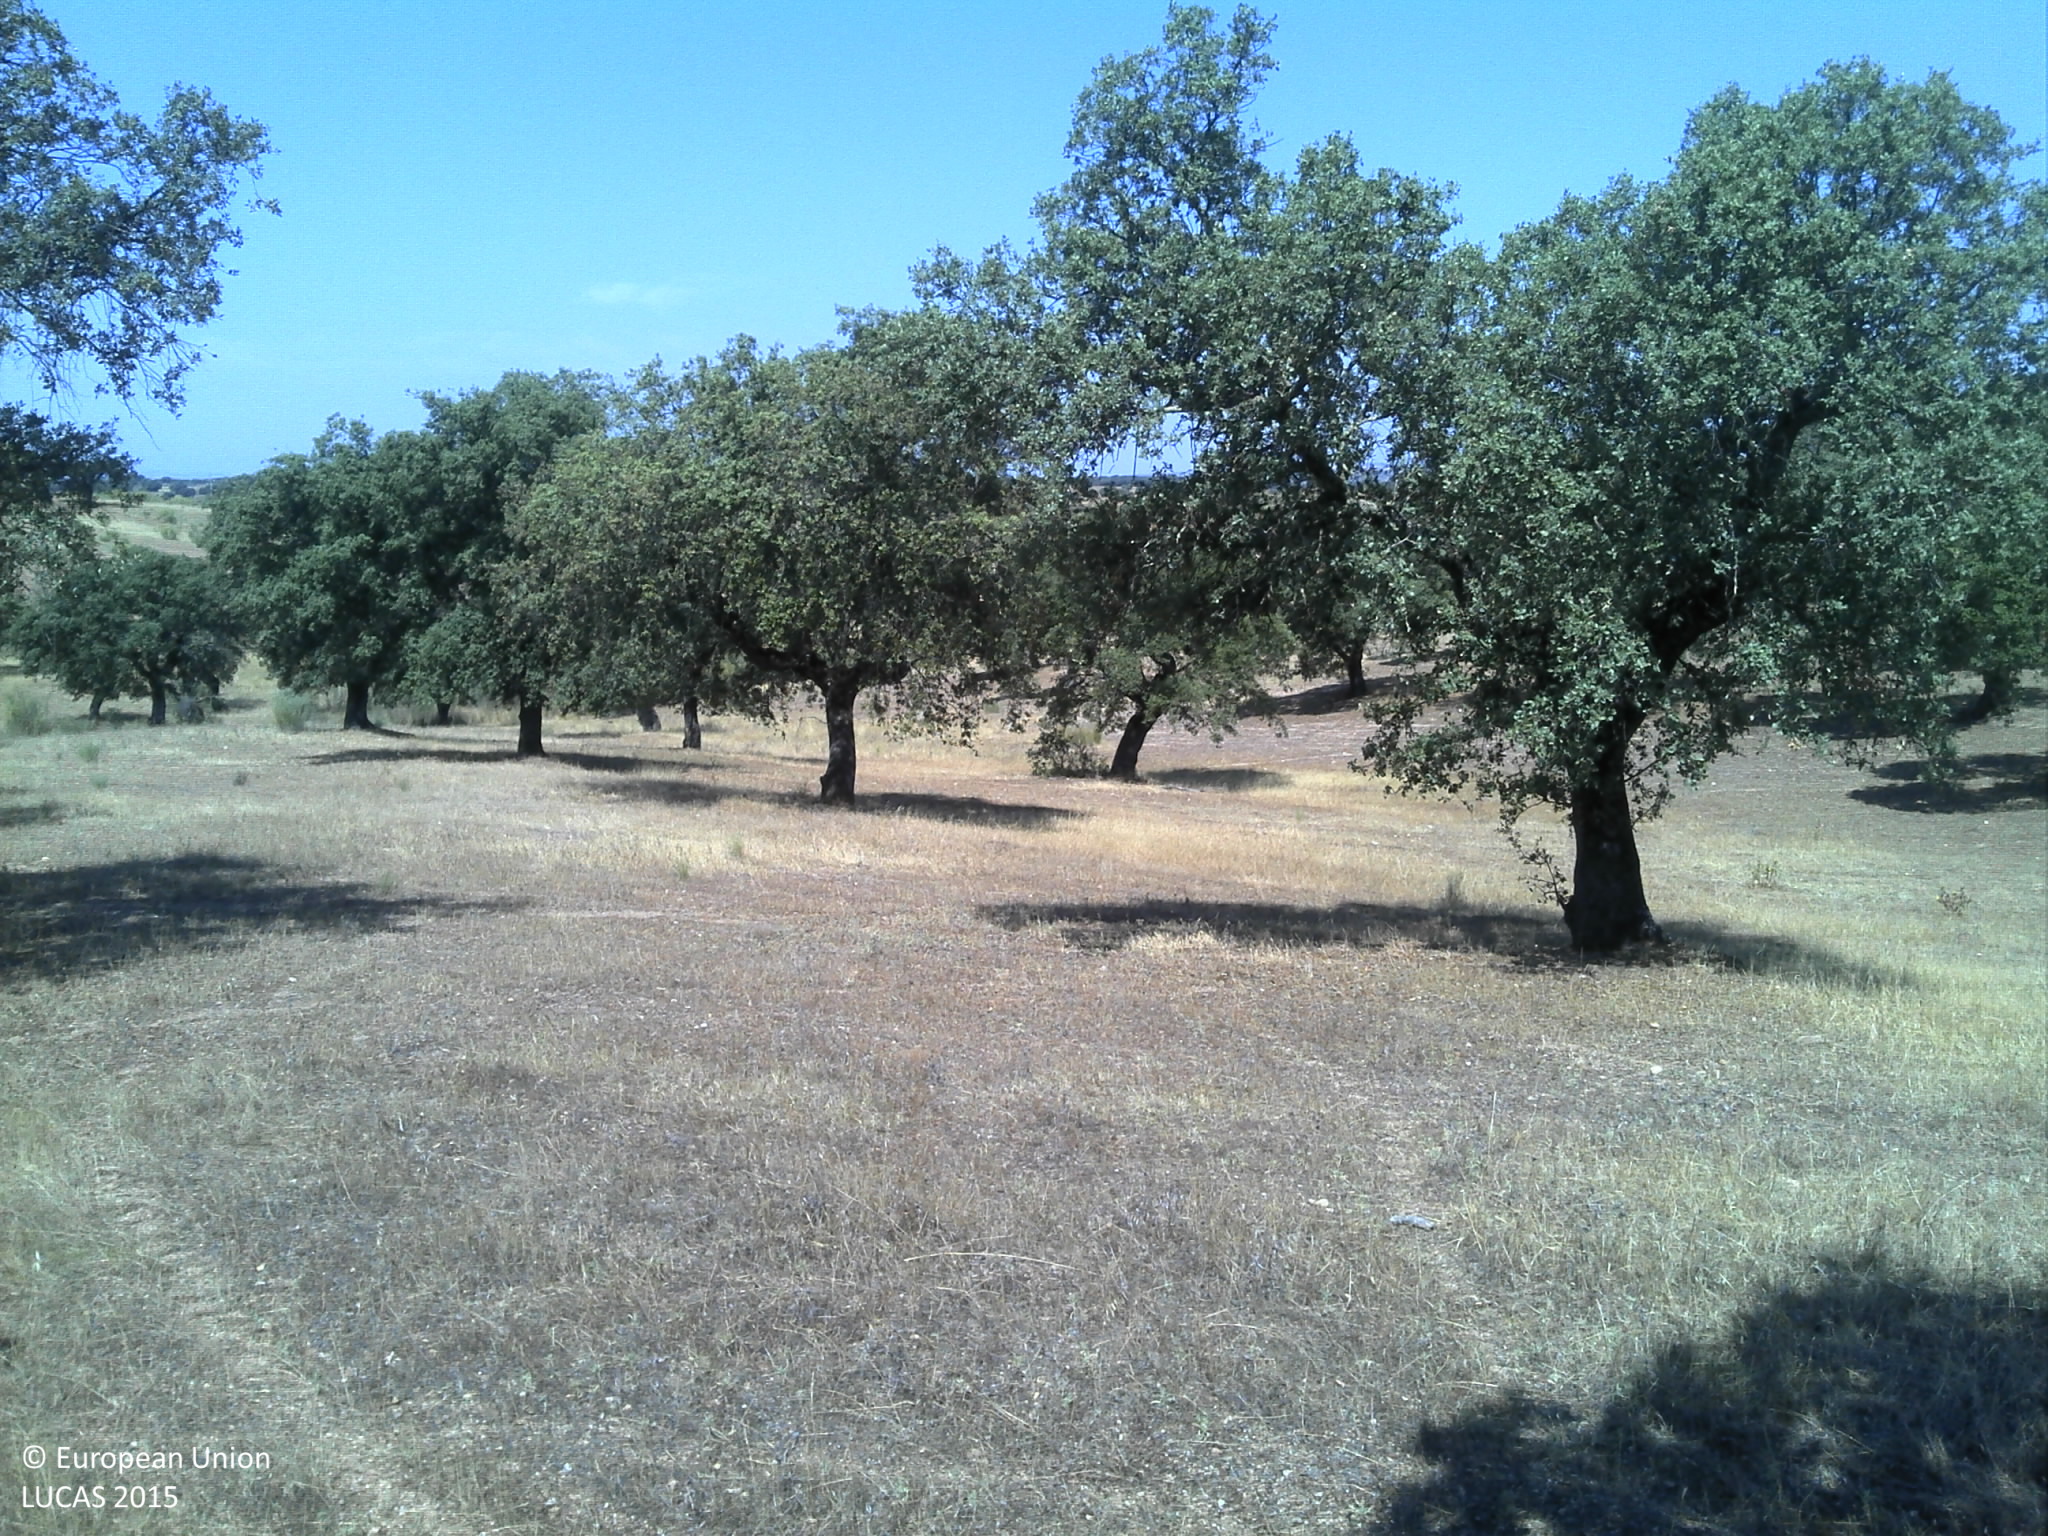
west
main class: Woodland
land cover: Broadleaved woodland
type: broadleaved evergreen forest
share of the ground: 25 - 50 %
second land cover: Spontaneously vegetated surfaces
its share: 25 - 50 %
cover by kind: broadleaved forest trees 40 %, herbaceous plants 30 %, unconsolidated bare surface 25 %
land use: Forestry
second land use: Agriculture (excluding fallow land and kitchen gardens)
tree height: > 5 m
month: June
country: PT
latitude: 39.8820
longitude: -7.0805
